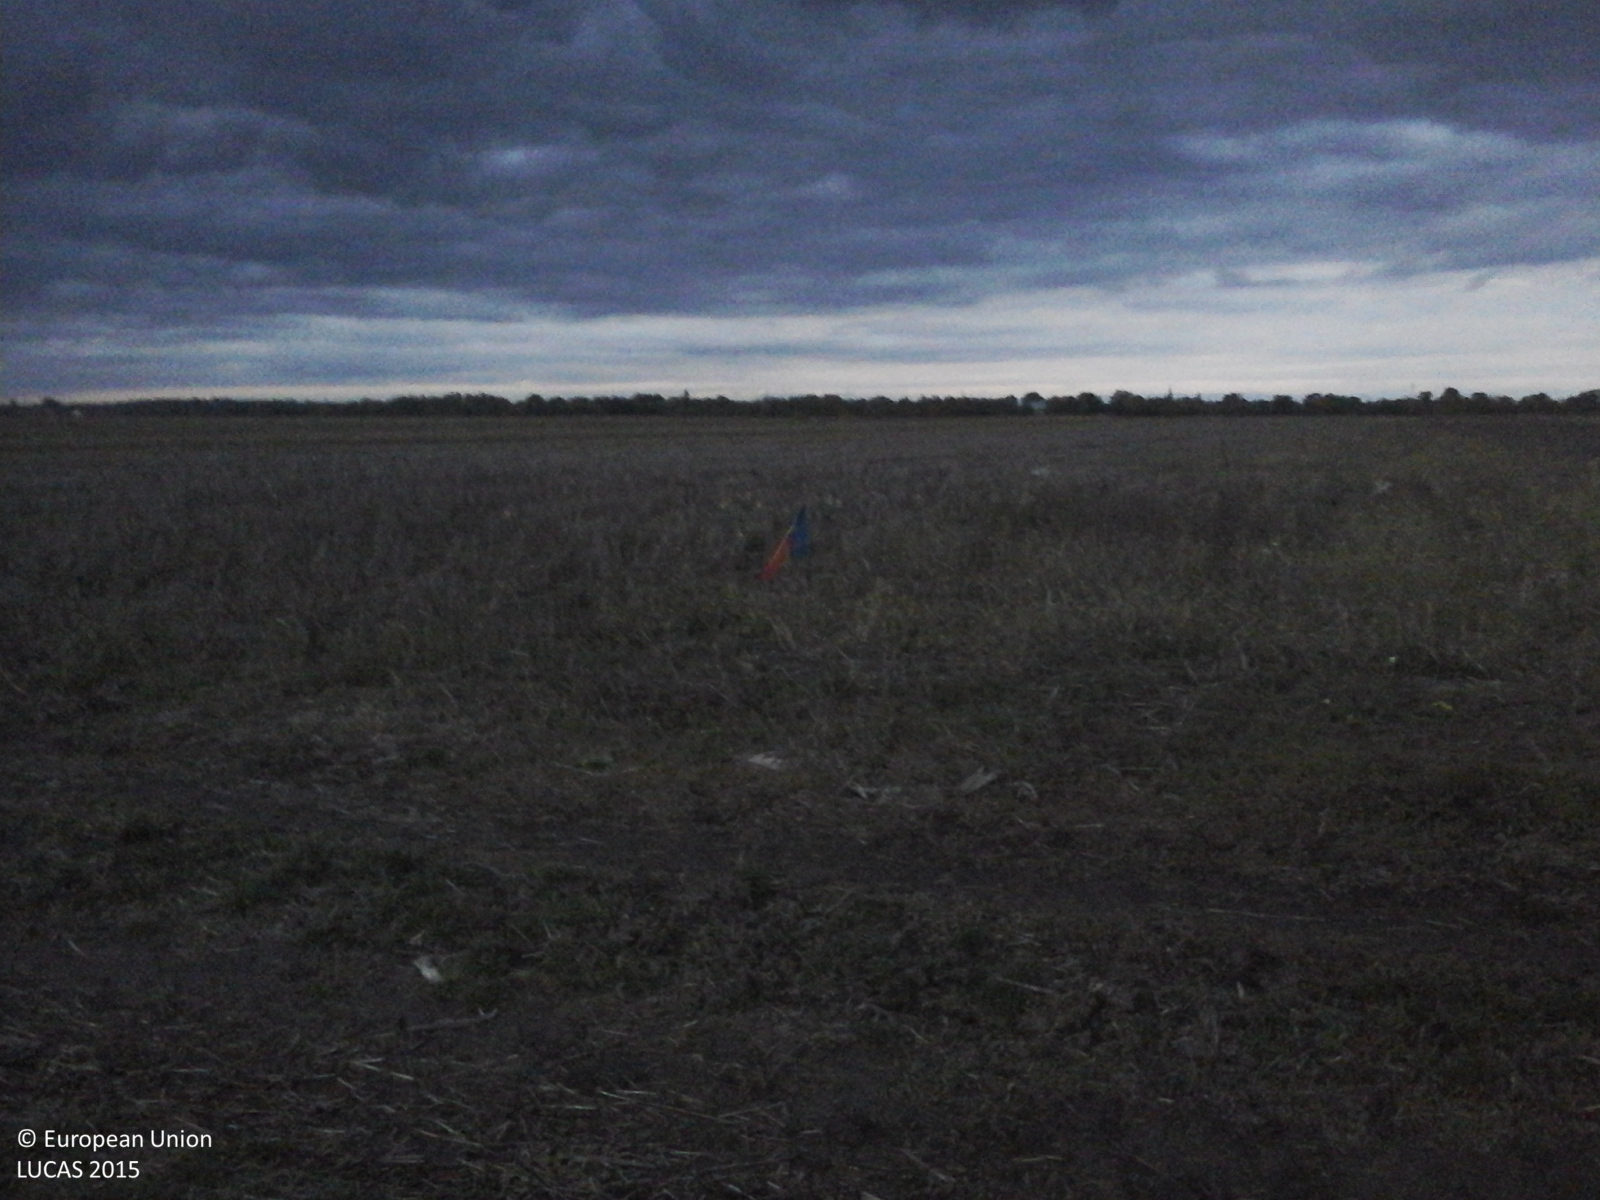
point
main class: Grassland
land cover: Spontaneously vegetated surfaces
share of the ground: > 75 %
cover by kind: herbaceous plants 100 %
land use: Fallow land
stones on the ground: < 10 %
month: October
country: RO
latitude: 44.7227
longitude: 25.9488
